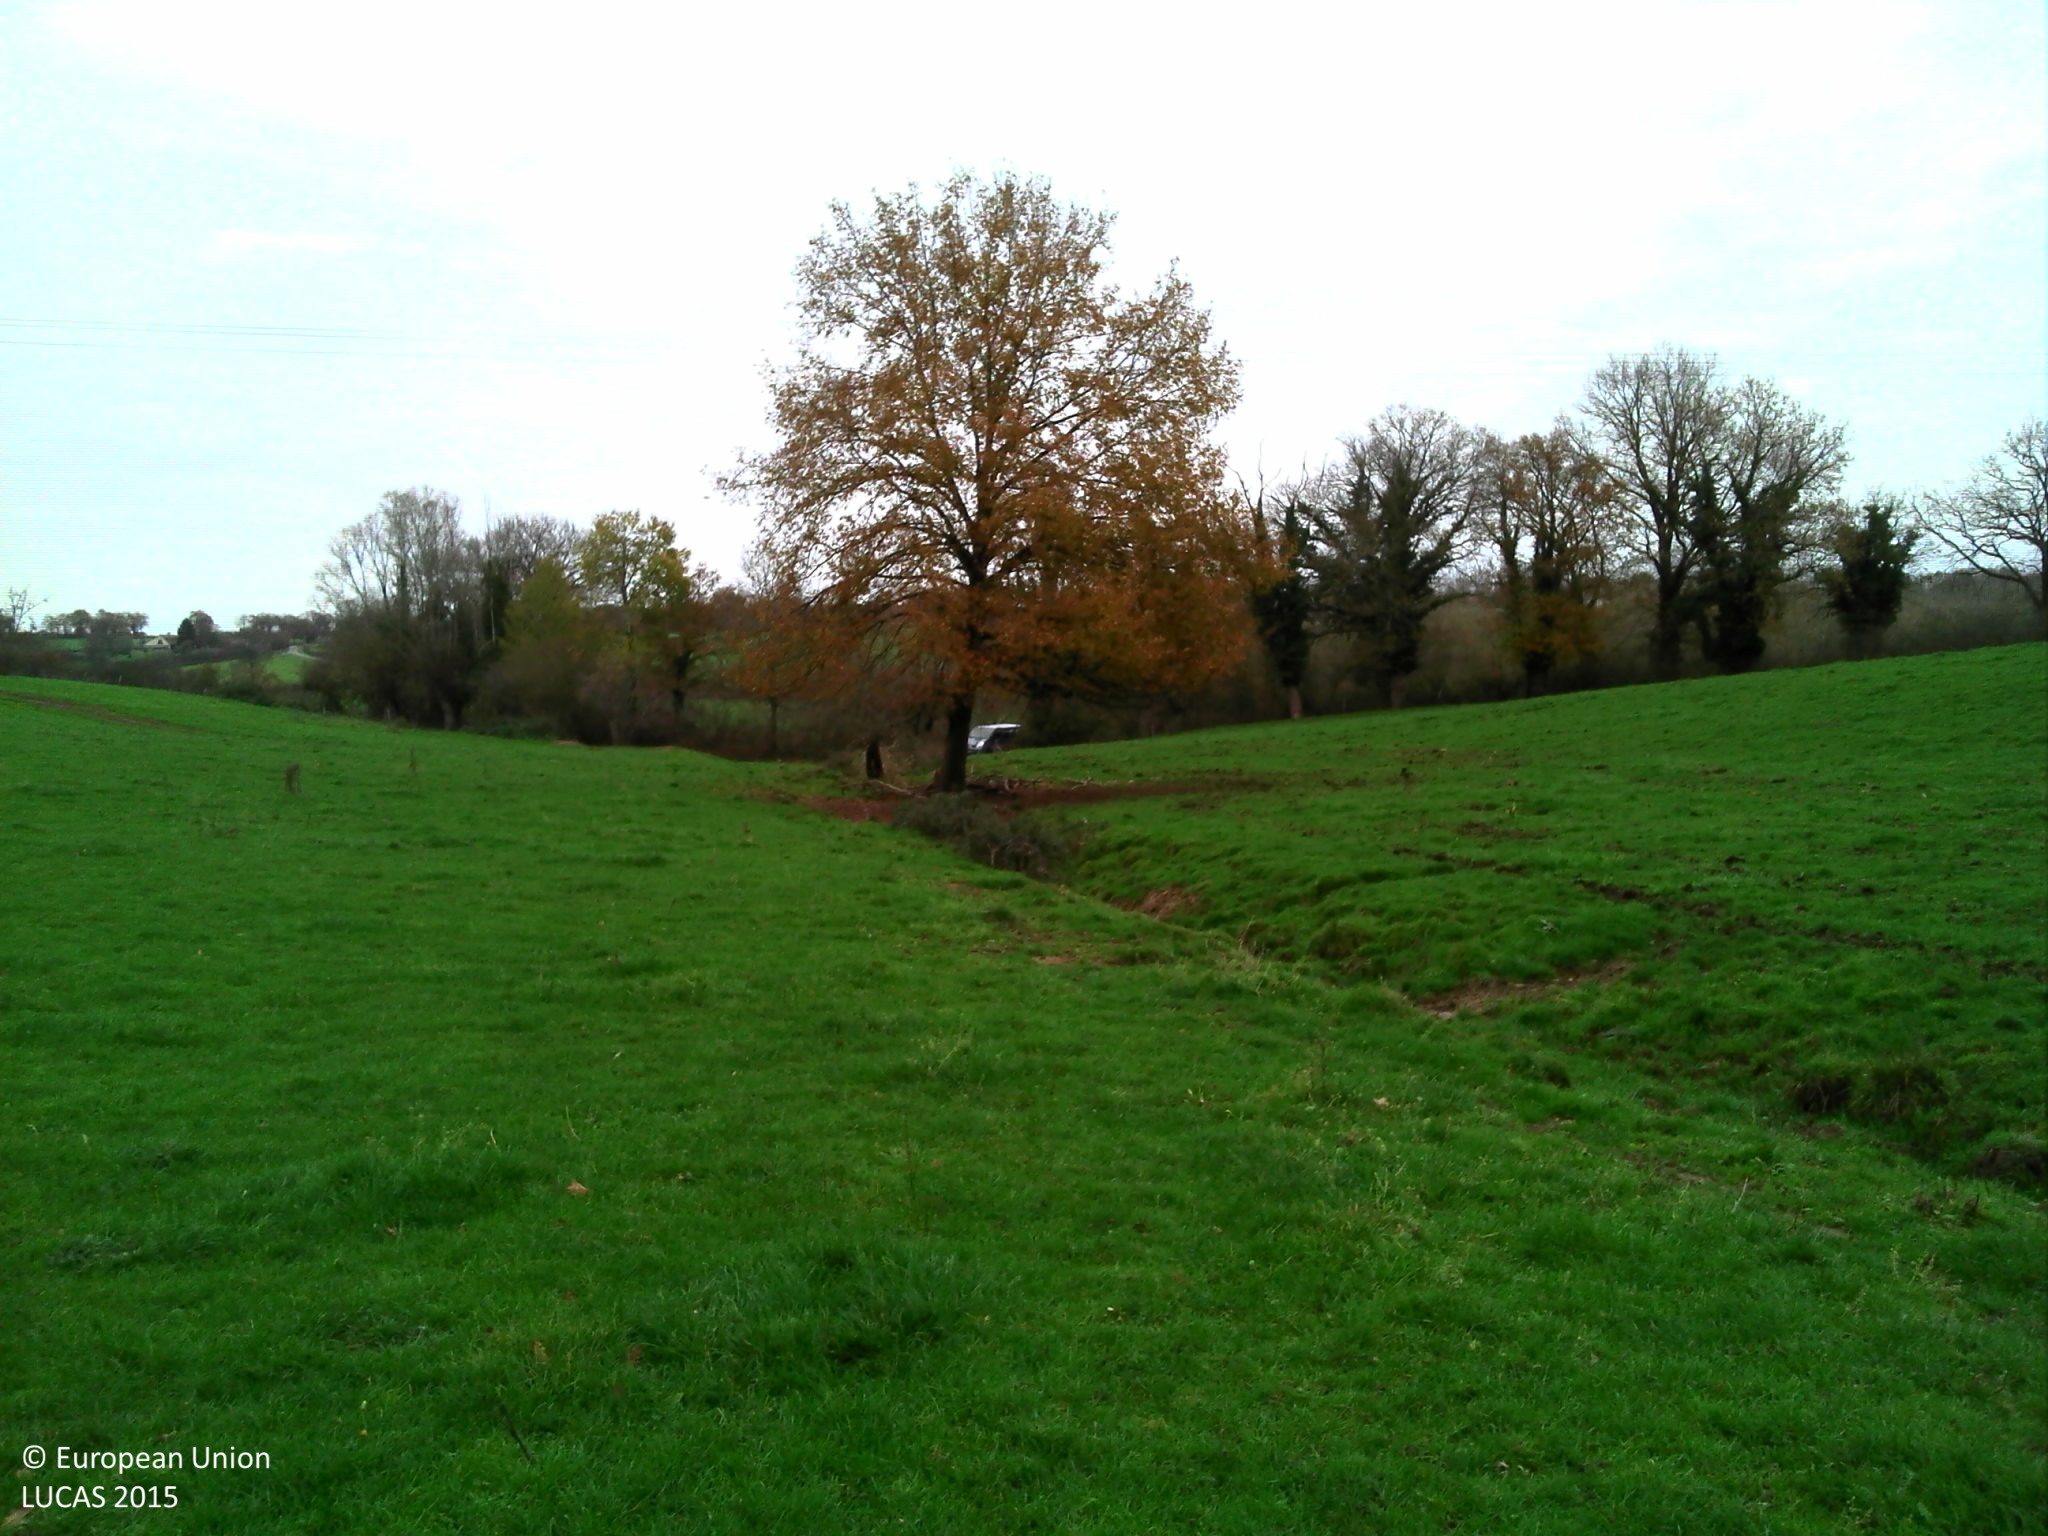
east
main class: Grassland
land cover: Grassland without tree/shrub cover
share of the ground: > 75 %
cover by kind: herbaceous plants 100 %
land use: Agriculture (excluding fallow land and kitchen gardens)
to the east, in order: Grassland without tree/shrub cover; Ditches and canals; Grassland without tree/shrub cover; Single bushes/trees; Grassland without tree/shrub cover; Electric lines; Grassland without tree/shrub cover; Fences; Abandoned hedges; Ditches and canals; Grass margins; Tracks; Grass margins; Fences; Lines of trees; Grassland without tree/shrub cover
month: July
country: FR
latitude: 46.6822
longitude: 3.0020
